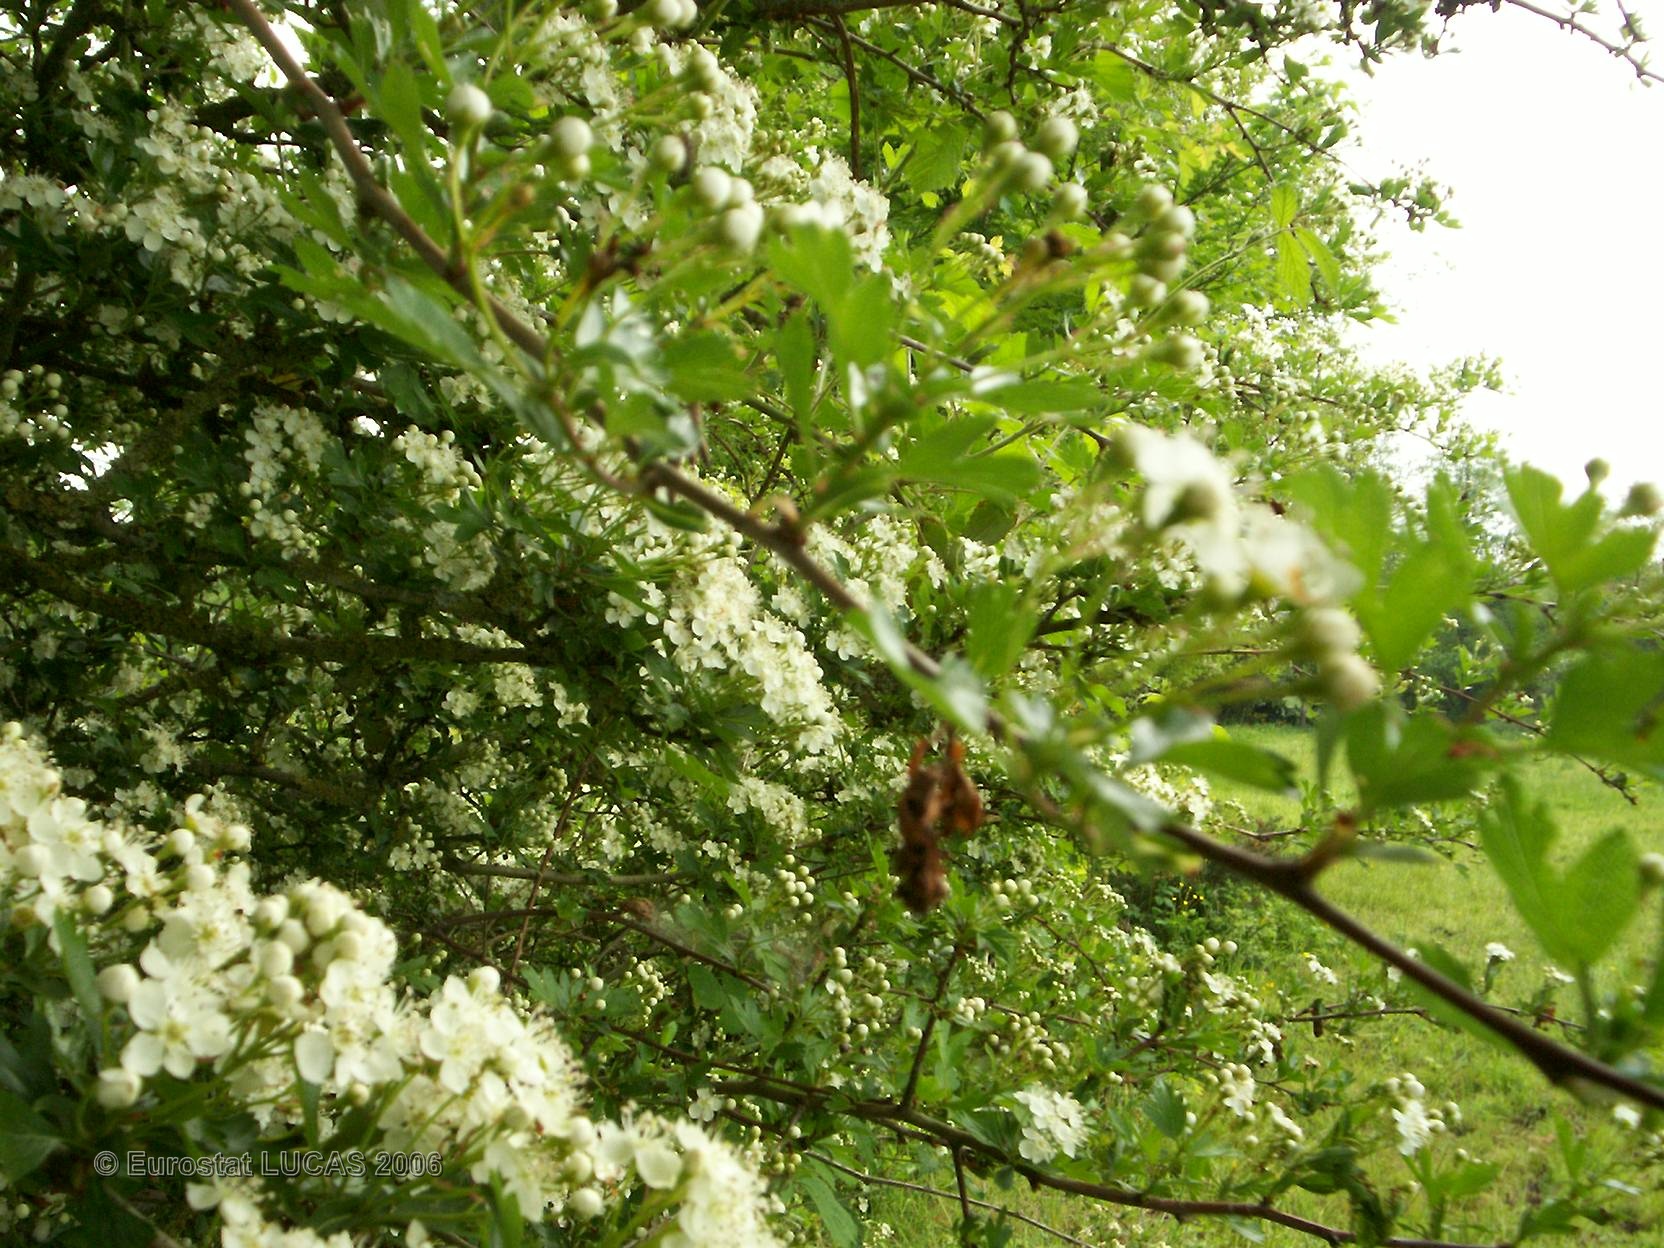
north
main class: Grassland
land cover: Grassland without tree/shrub cover
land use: Agriculture (excluding fallow land and kitchen gardens)
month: May
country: FR
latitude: 47.7438
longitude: -1.5274
